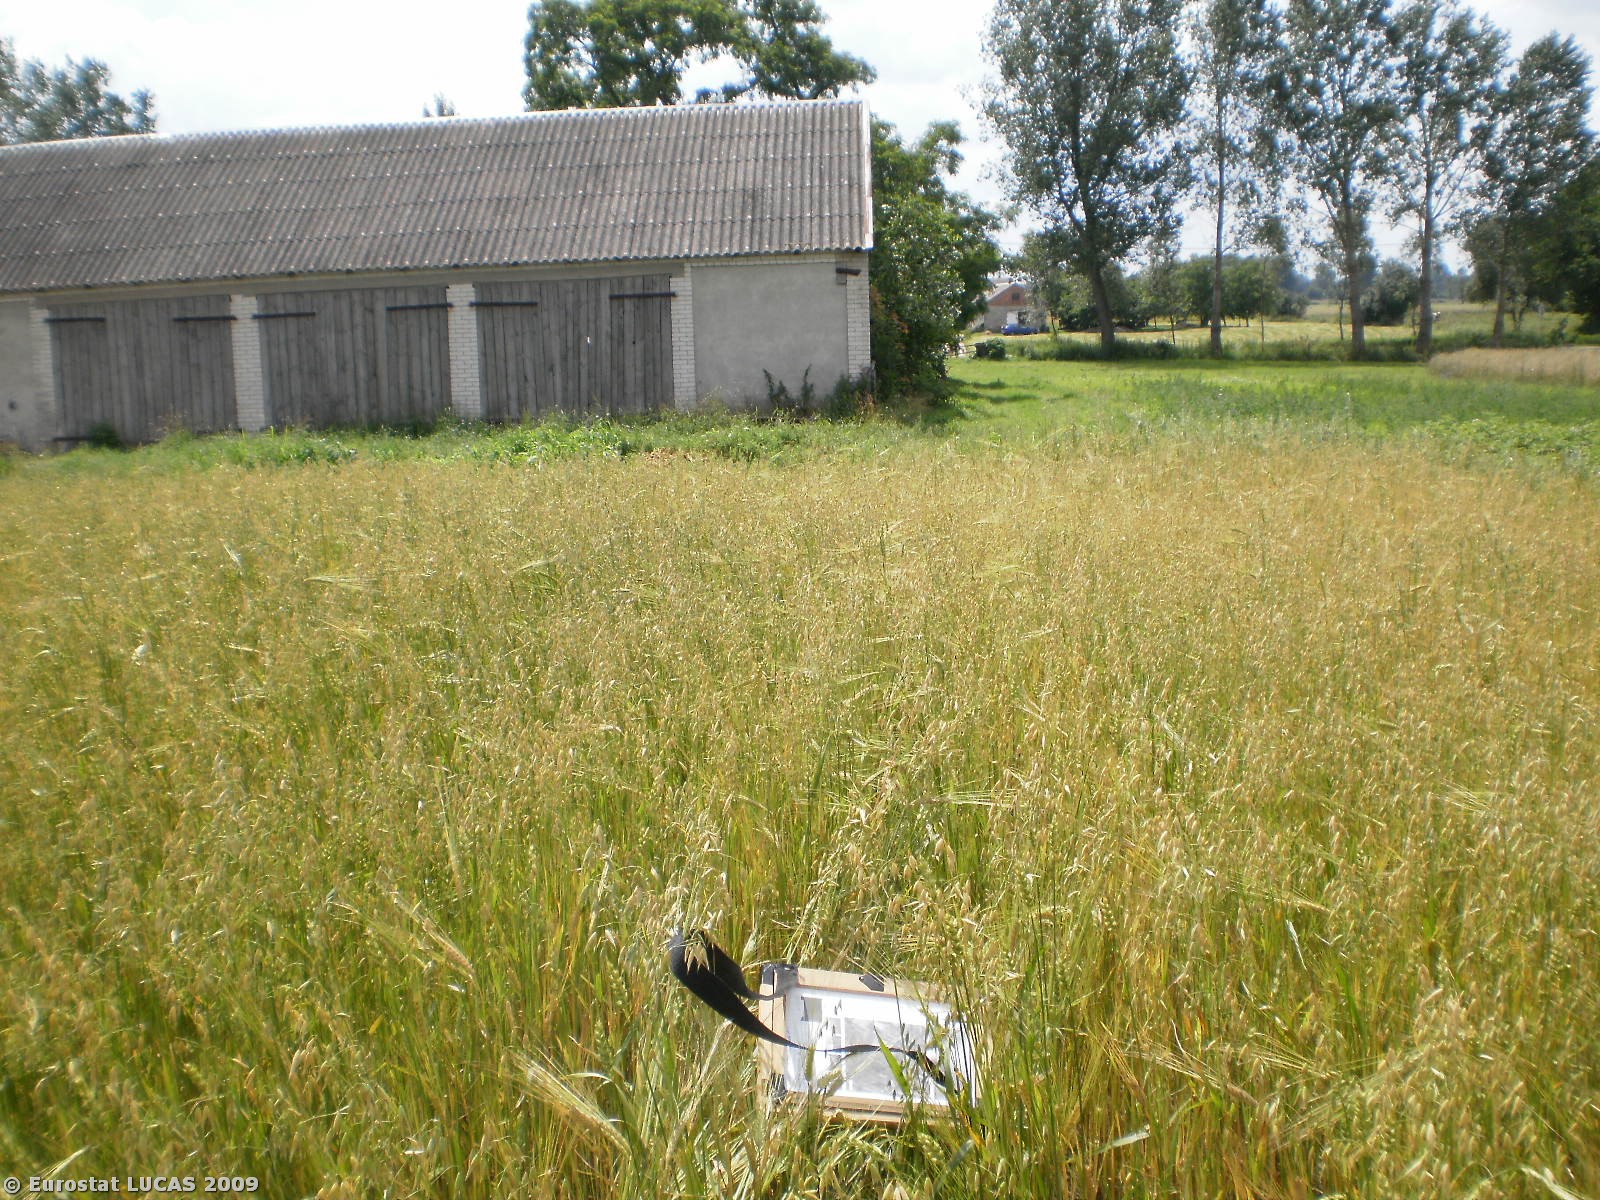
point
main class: Cropland
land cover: Mixed cereals for fodder
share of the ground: > 75 %
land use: Agriculture (excluding fallow land and kitchen gardens)
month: July
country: PL
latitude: 52.9342
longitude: 20.4066
